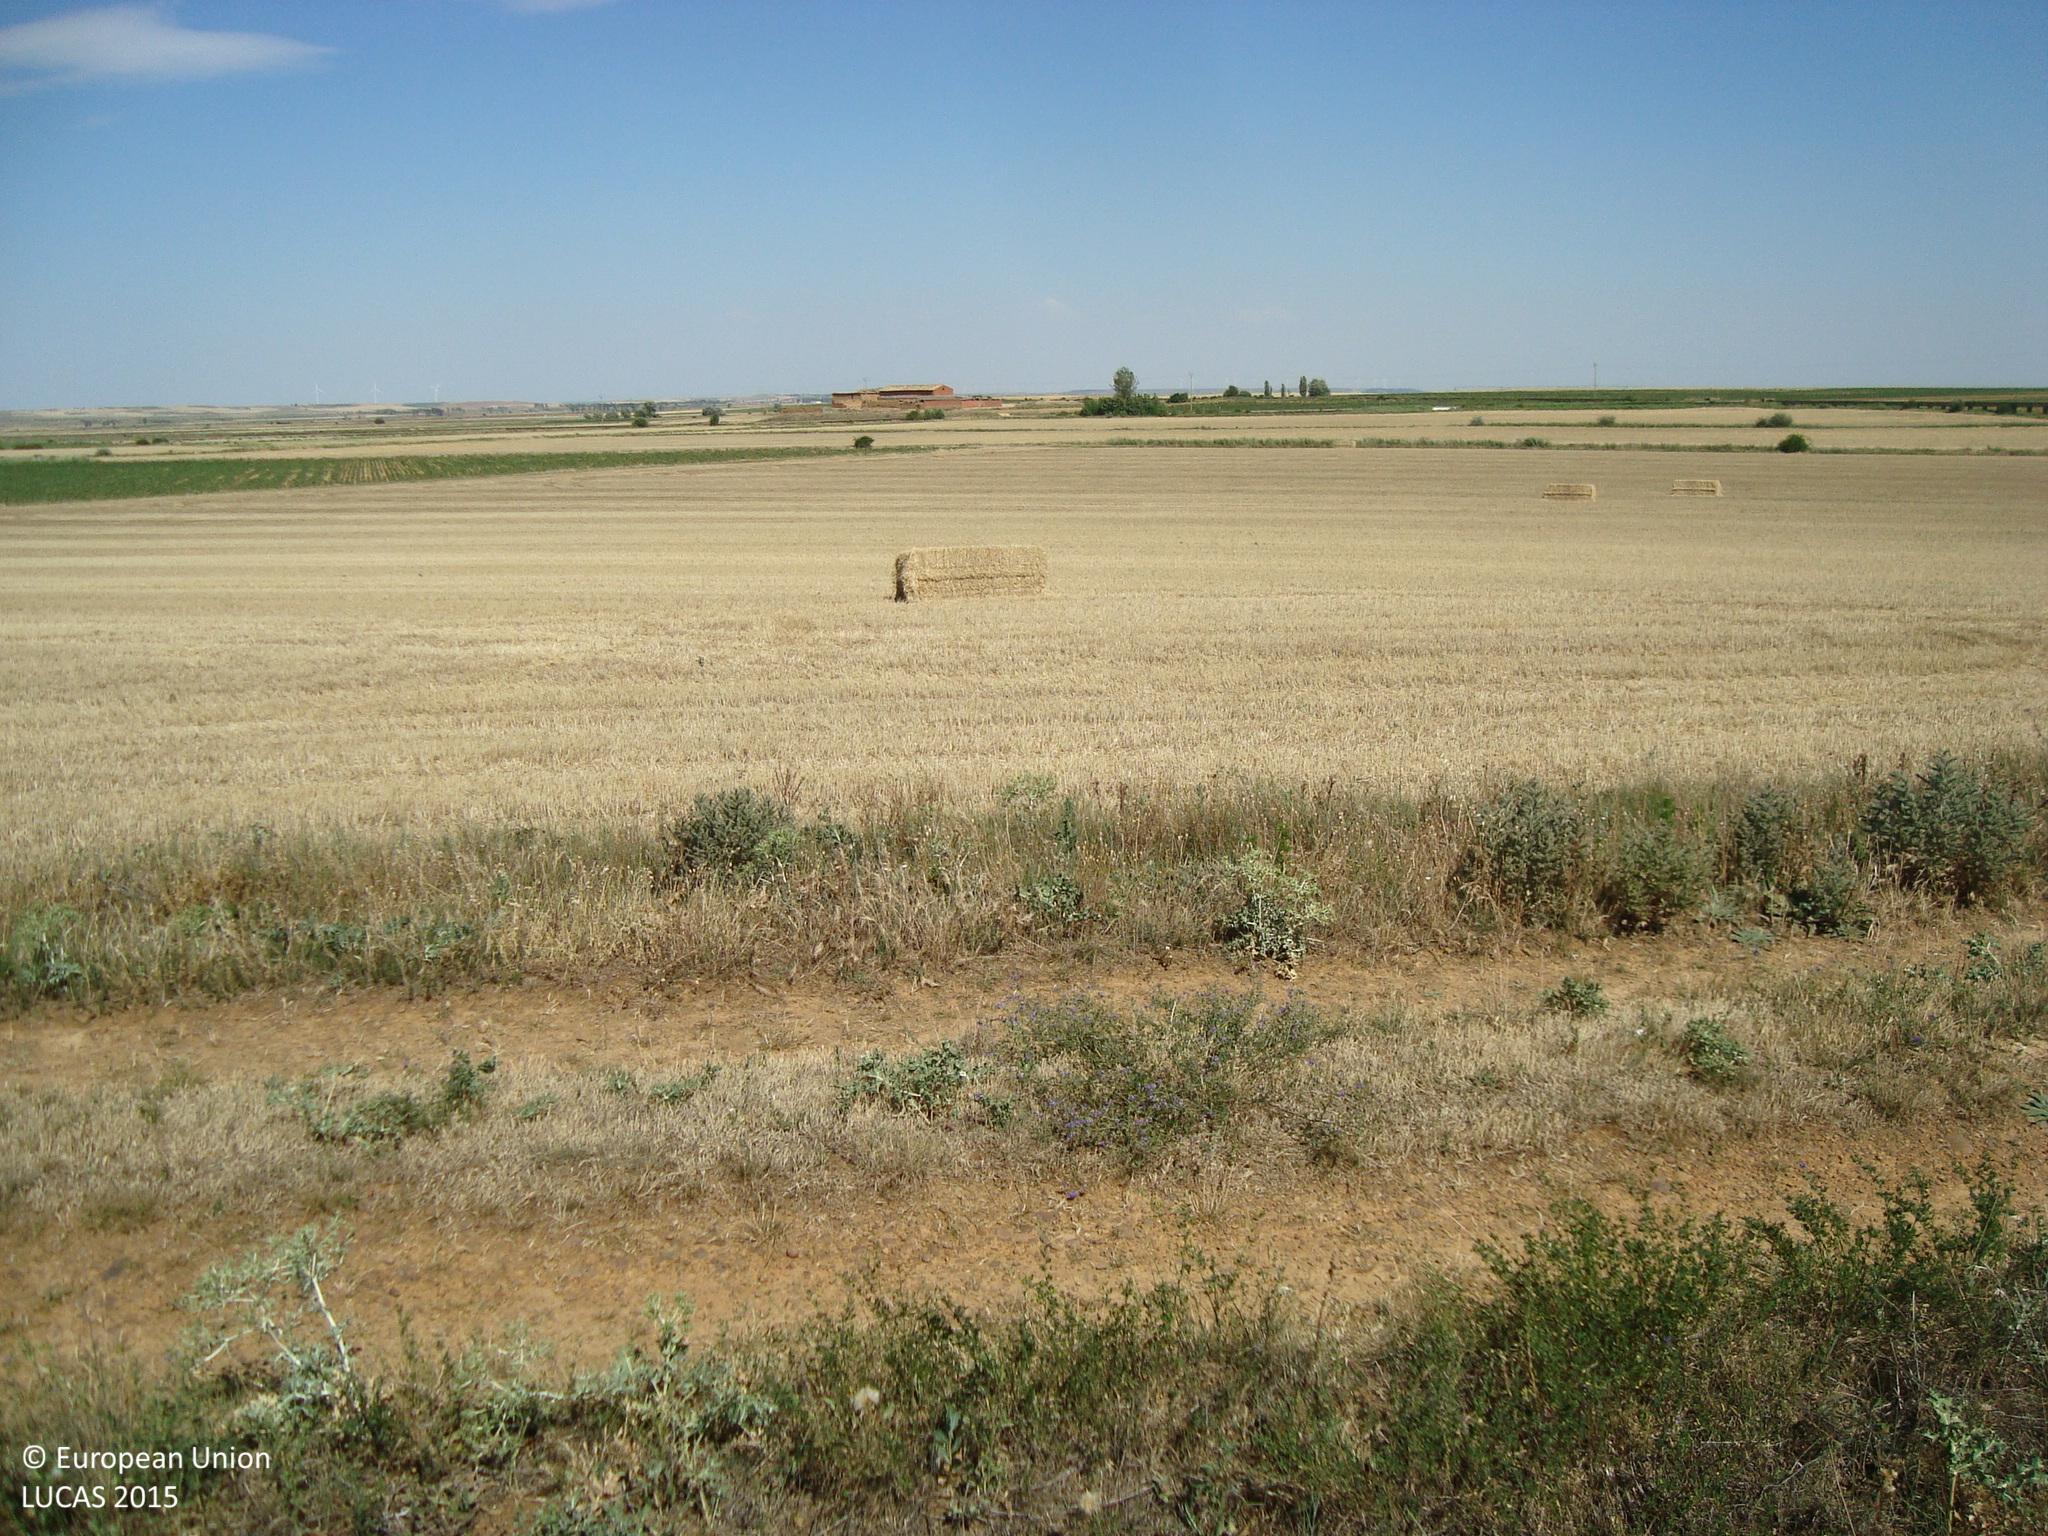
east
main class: Cropland
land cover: Barley
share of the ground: < 10 %
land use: Agriculture (excluding fallow land and kitchen gardens)
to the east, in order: Ditches and canals; Grass margins; Tracks; Grass margins; Barley; Grass margins; Sunflower
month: July
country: ES
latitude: 42.1142
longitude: -4.7704
